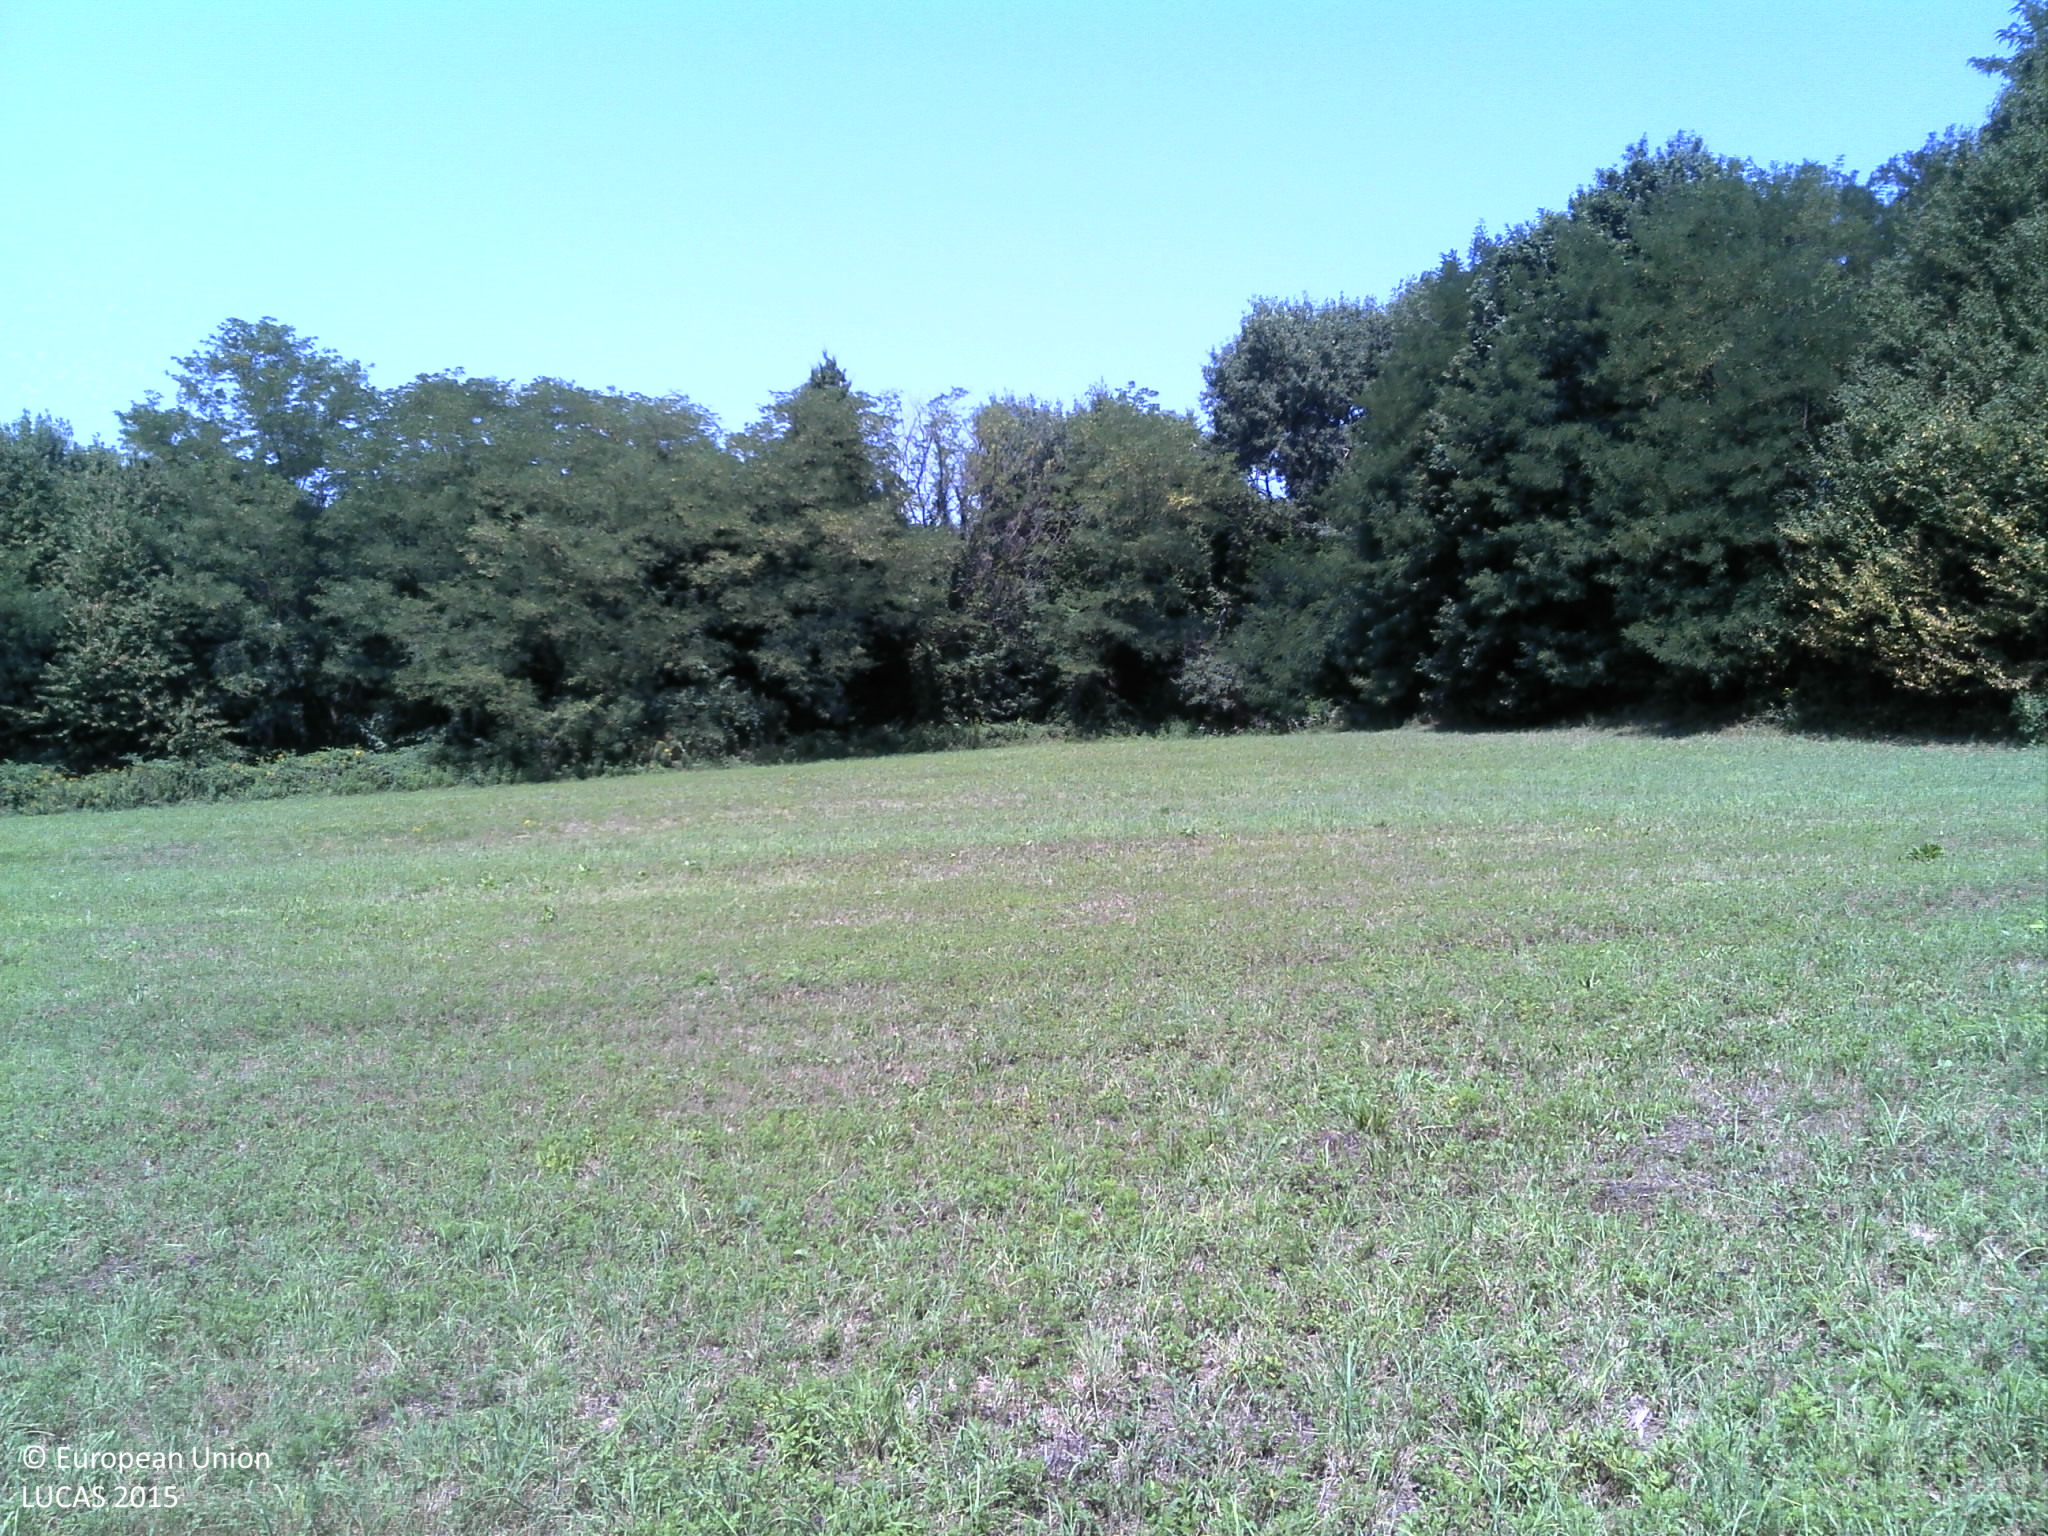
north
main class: Grassland
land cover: Spontaneously vegetated surfaces
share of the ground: > 75 %
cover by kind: herbaceous plants 100 %
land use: Semi-natural and natural areas not in use
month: August
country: HR
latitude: 46.0991
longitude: 16.7921
